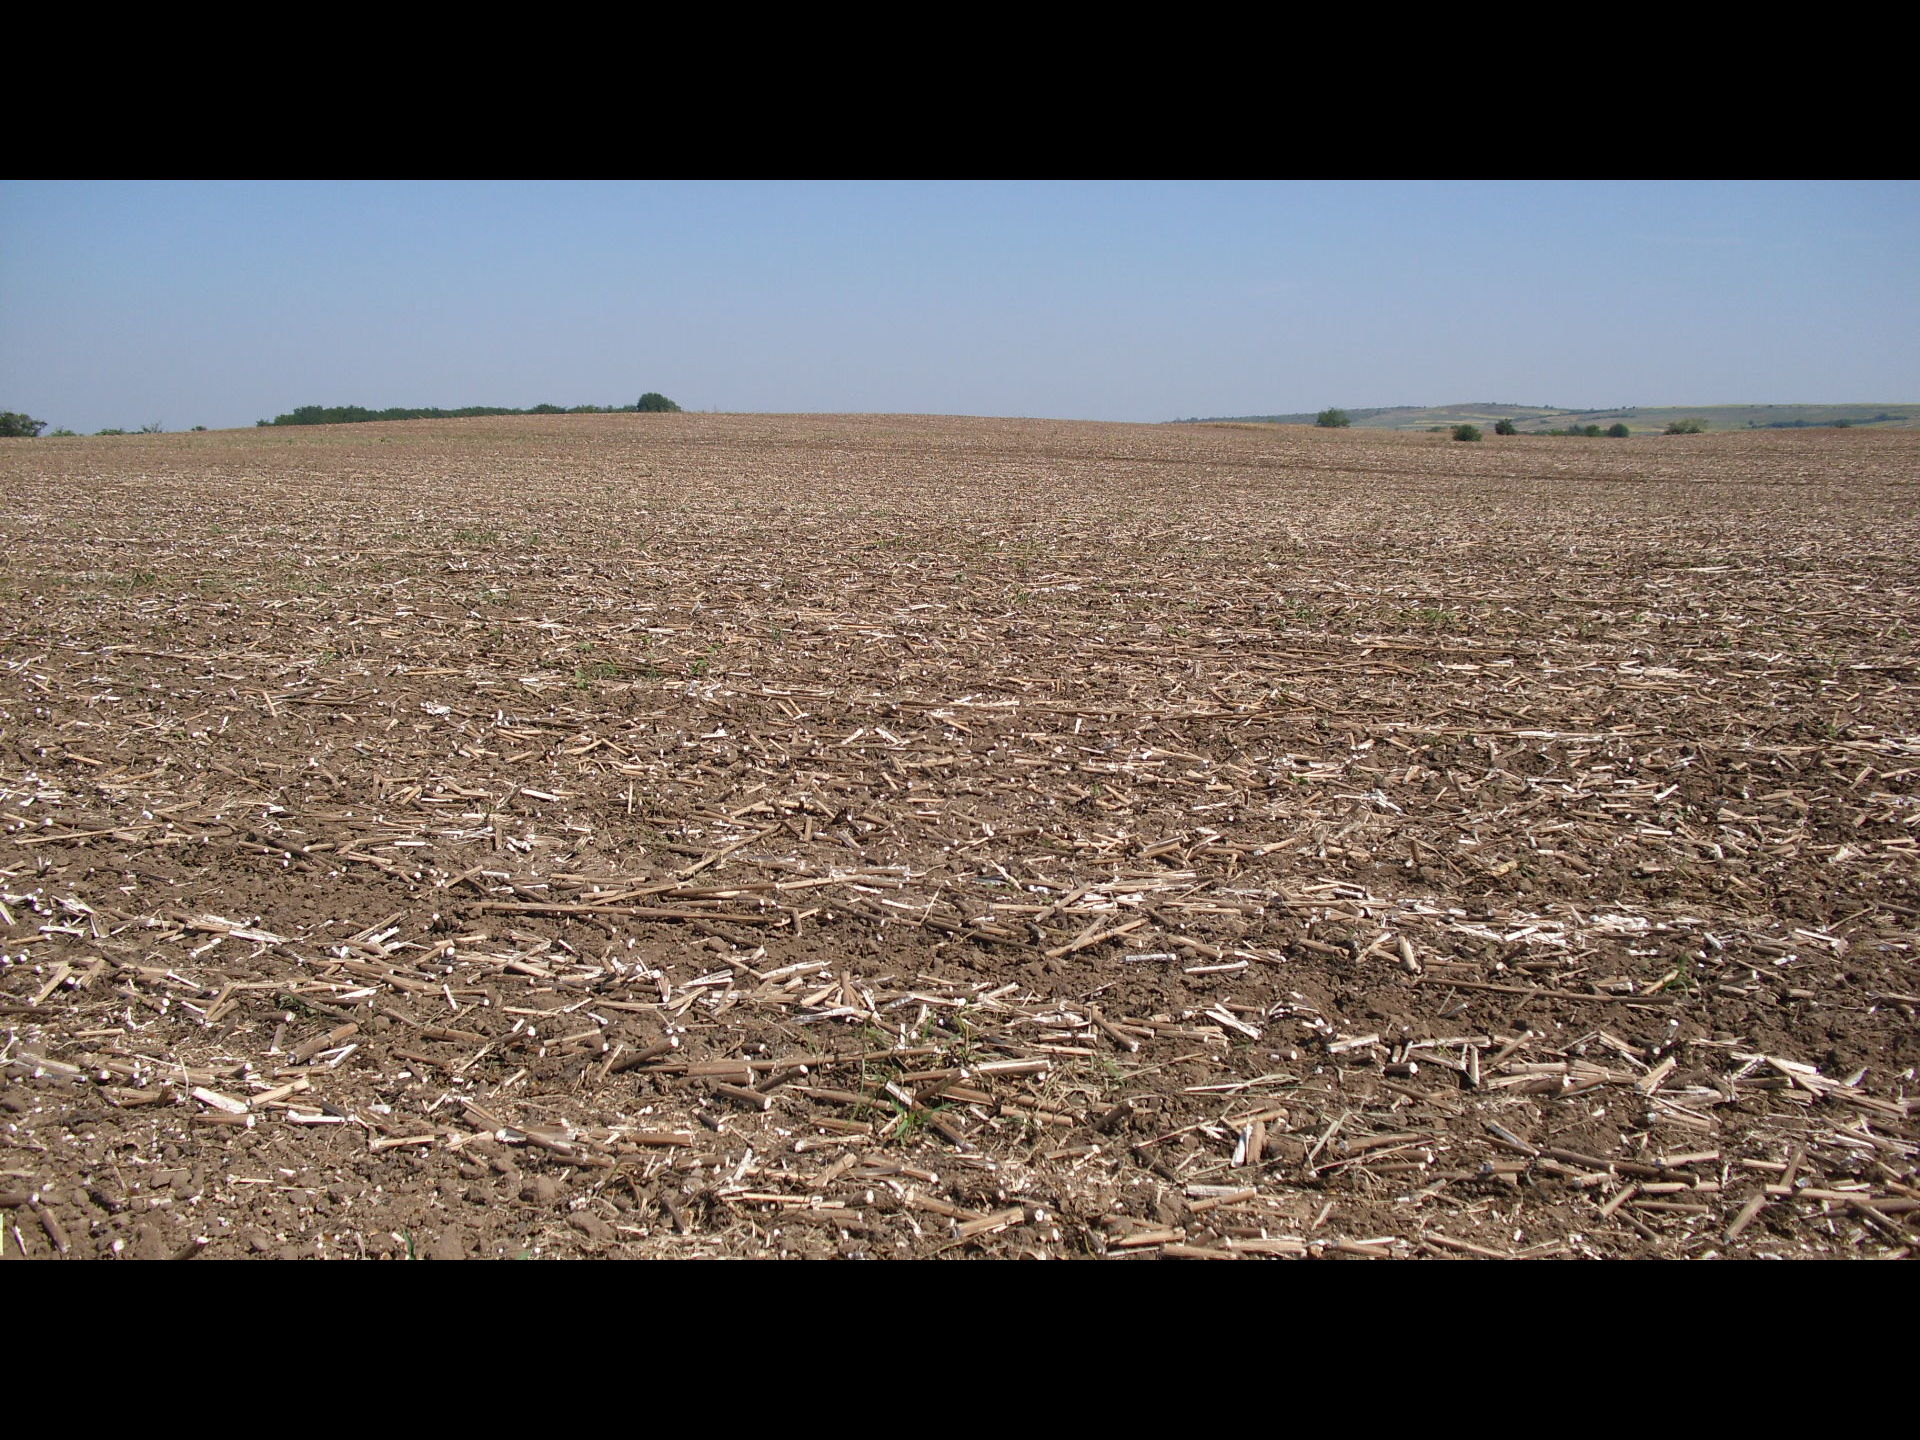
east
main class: Cropland
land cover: Sunflower
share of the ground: < 10 %
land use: Agriculture (excluding fallow land and kitchen gardens)
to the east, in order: Sunflower
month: August
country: BG
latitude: 44.1230
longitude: 22.7734
